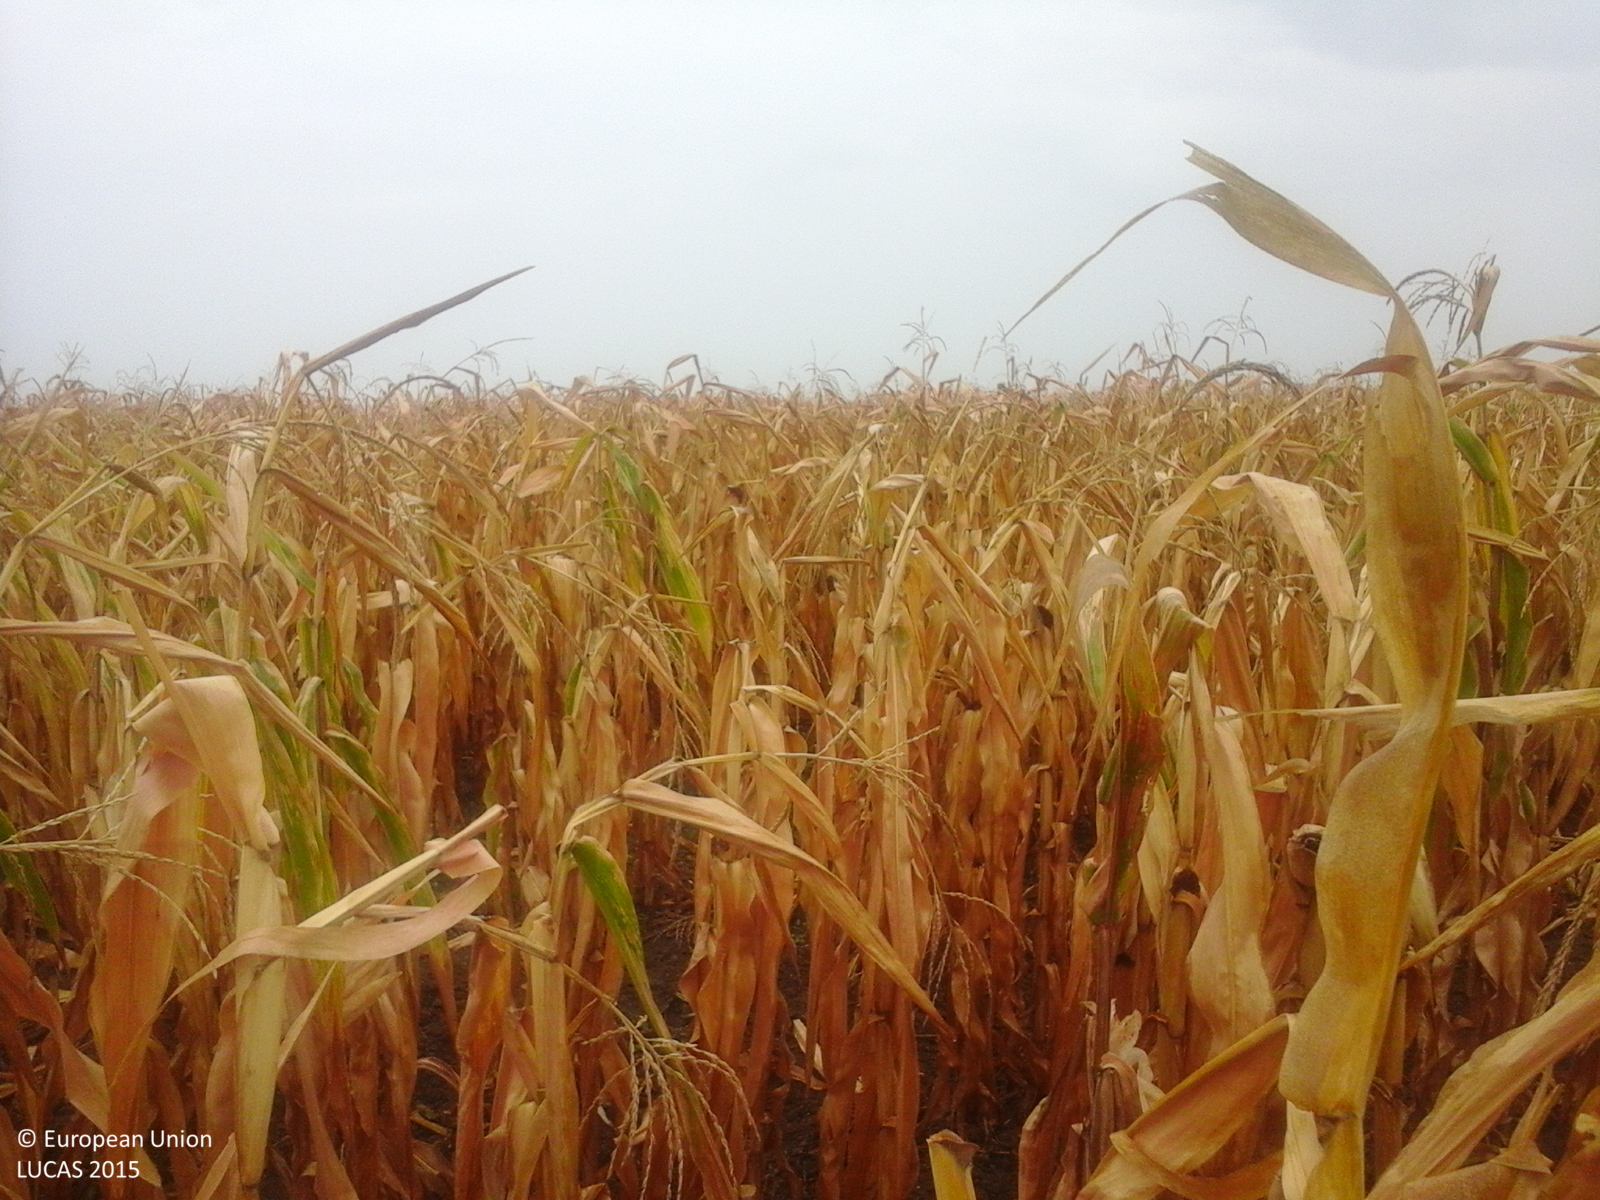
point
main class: Cropland
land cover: Maize
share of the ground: > 75 %
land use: Agriculture (excluding fallow land and kitchen gardens)
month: September
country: RO
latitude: 47.7452
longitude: 22.5020
